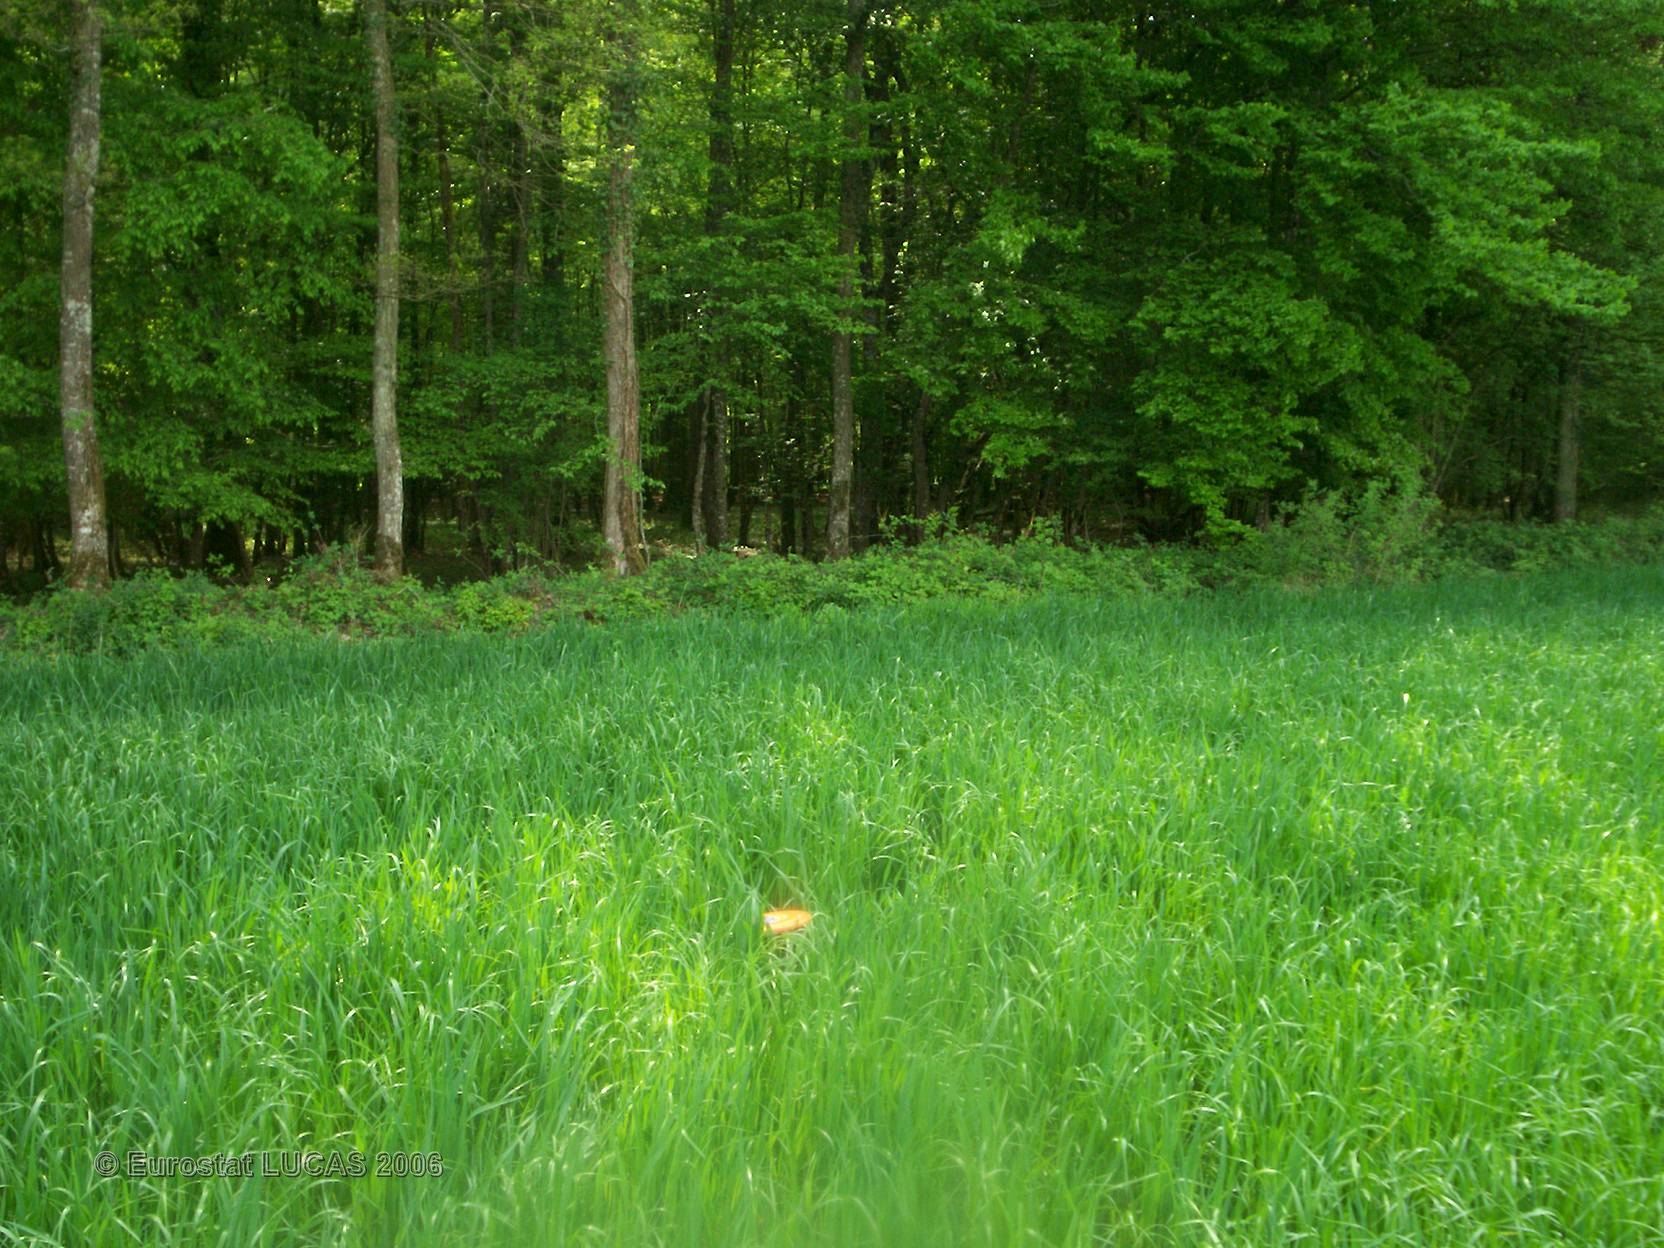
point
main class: Cropland
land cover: Barley
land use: Agriculture (excluding fallow land and kitchen gardens)
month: May
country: FR
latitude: 47.8745
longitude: 3.0006
